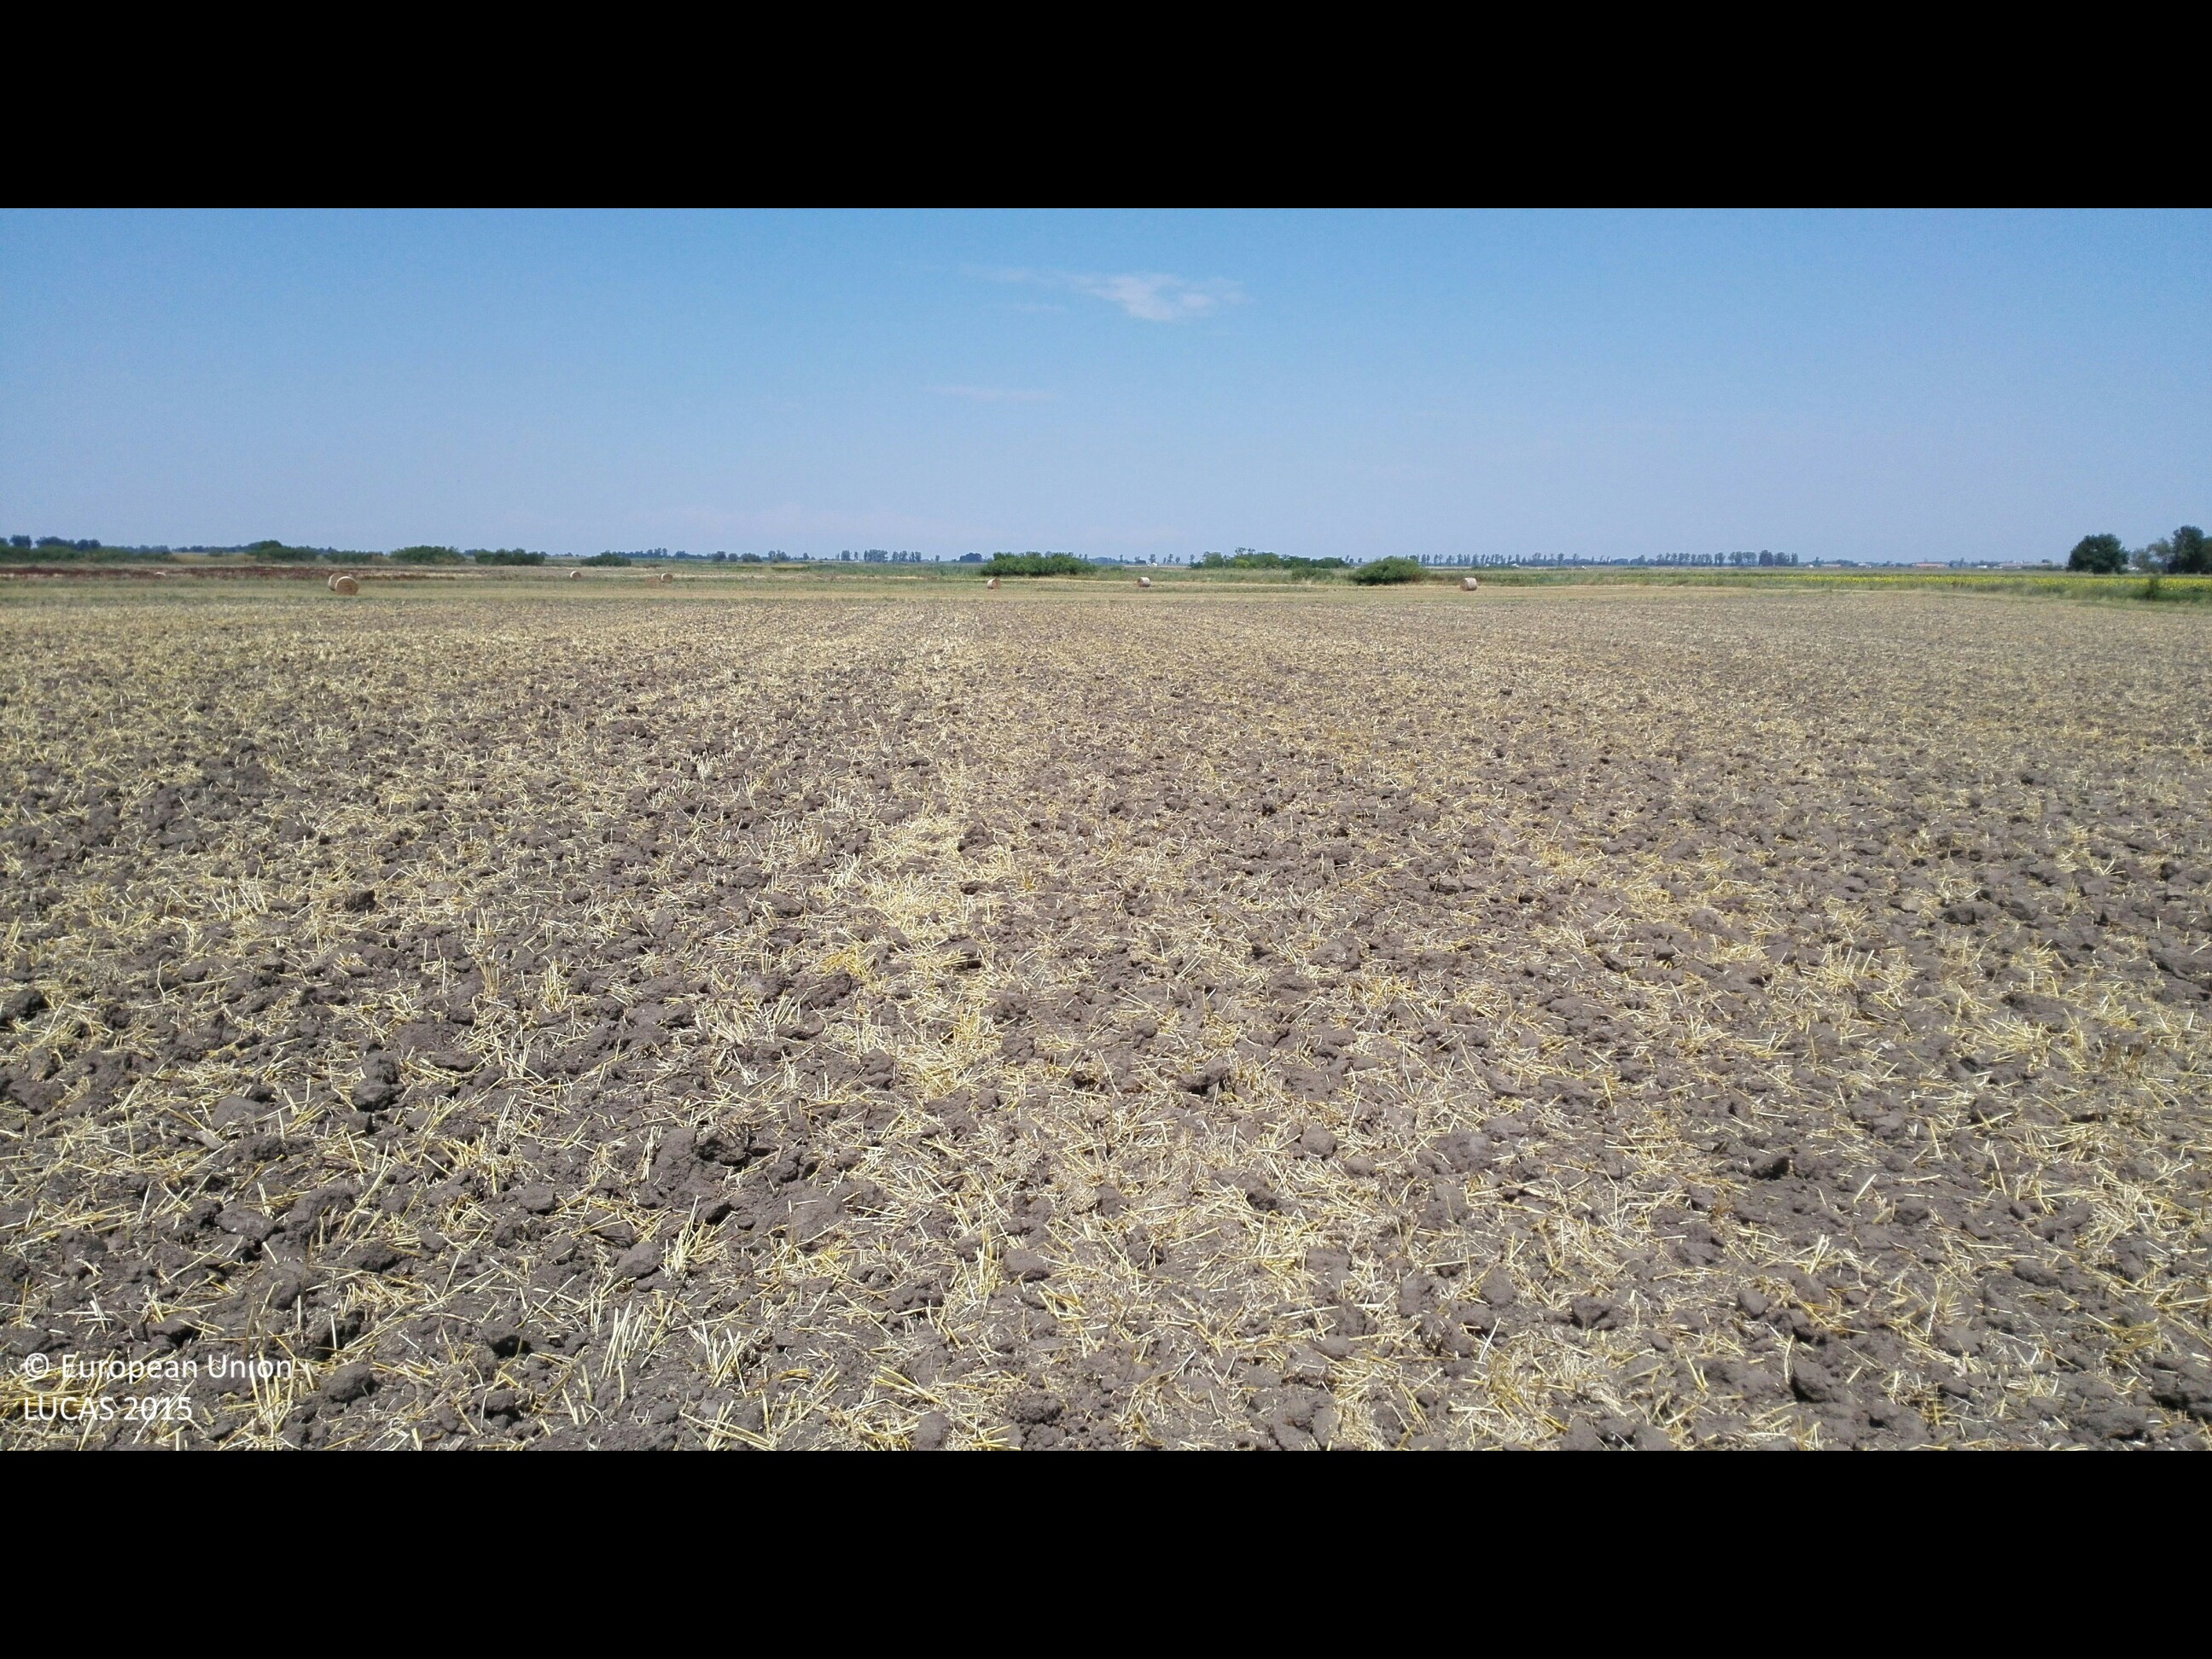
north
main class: Cropland
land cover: Barley
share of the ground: < 10 %
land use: Agriculture (excluding fallow land and kitchen gardens)
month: July
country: HU
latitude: 47.2400
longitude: 21.3075
